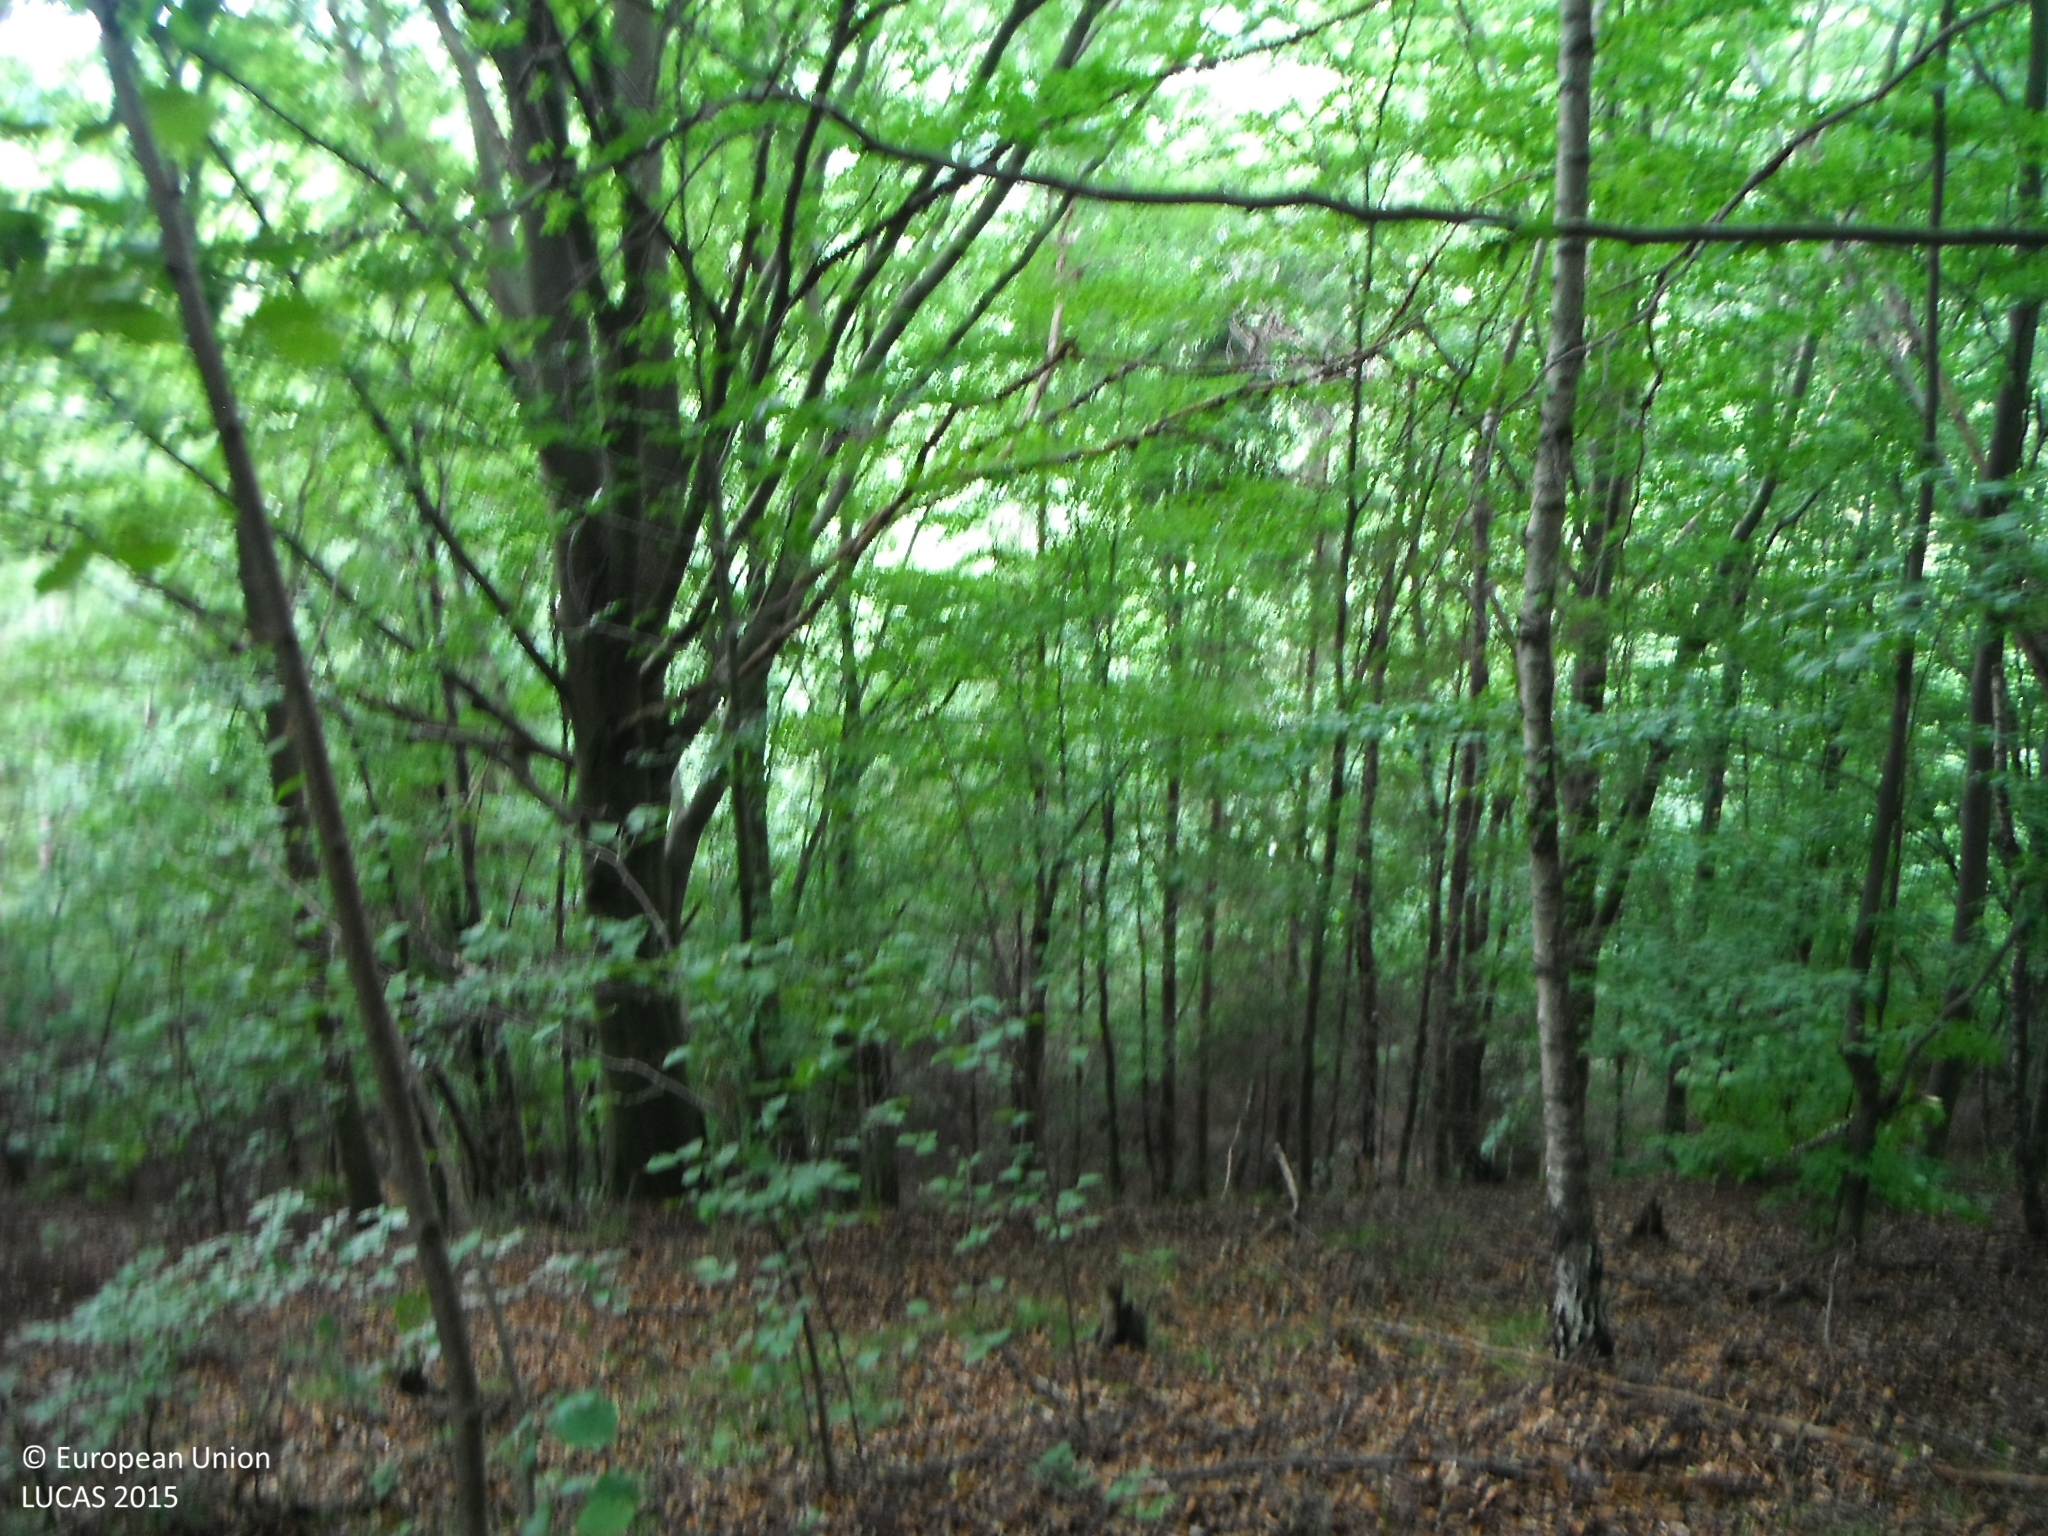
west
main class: Woodland
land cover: Broadleaved woodland
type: beech forest
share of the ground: > 75 %
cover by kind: broadleaved forest trees 100 %
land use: Forestry
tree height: > 5 m
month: July
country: SK
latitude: 48.8307
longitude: 20.8424
